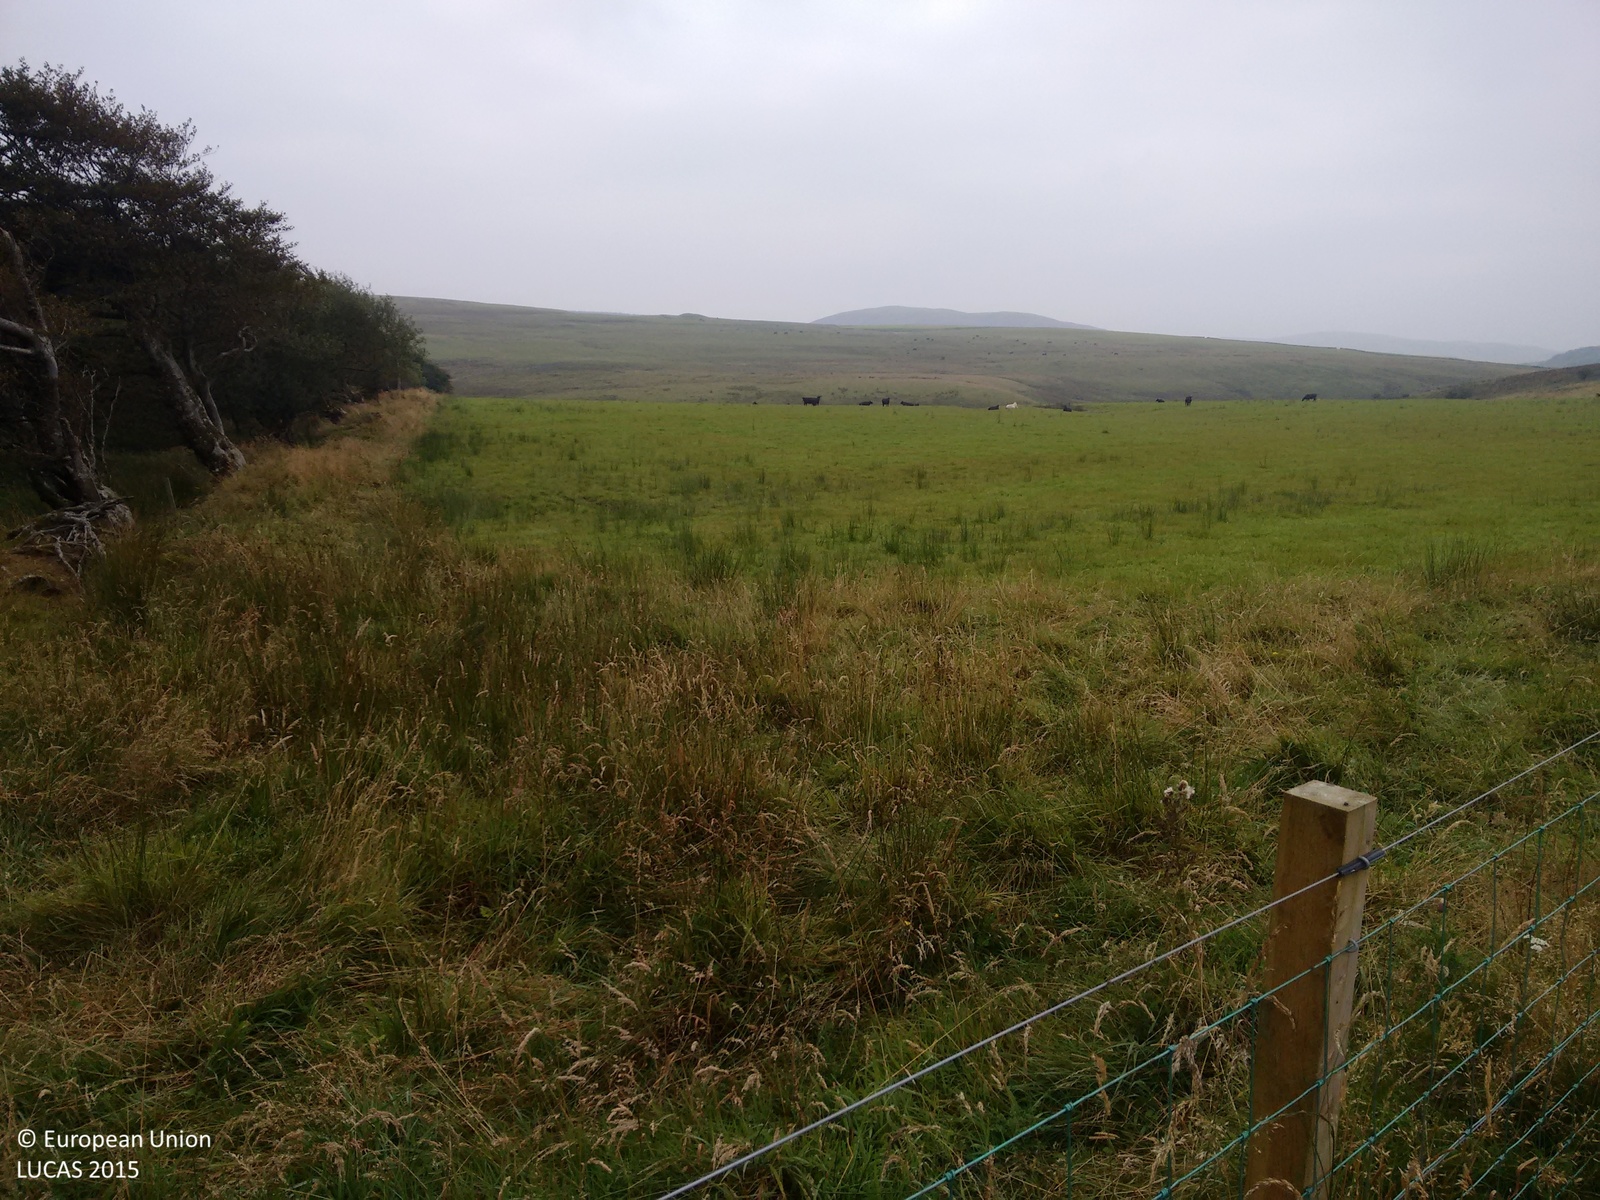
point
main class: Grassland
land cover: Grassland without tree/shrub cover
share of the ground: > 75 %
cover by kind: herbaceous plants 100 %
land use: Agriculture (excluding fallow land and kitchen gardens)
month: September
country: GB
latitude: 55.1876
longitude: -4.8578
